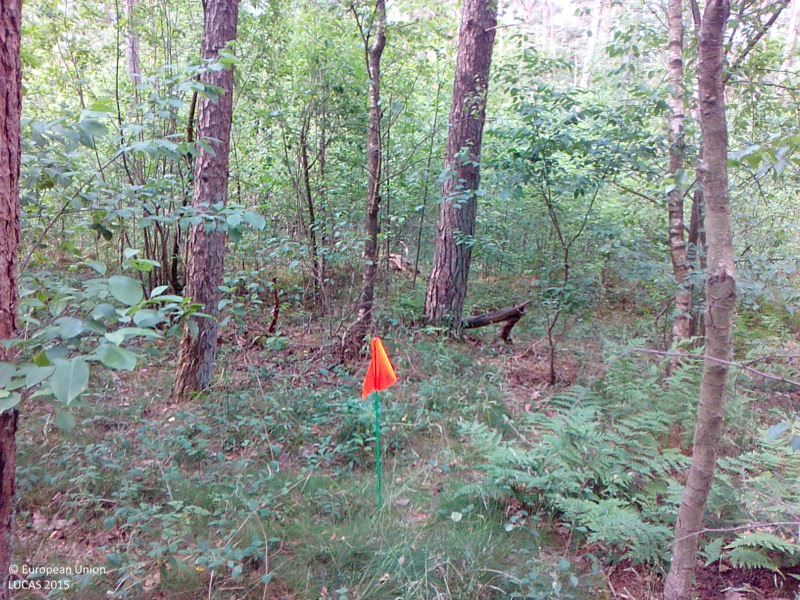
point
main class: Woodland
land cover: Pine dominated mixed woodland
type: hemiboreal forest and nemoral coniferous forest and mixed broadleaved-coniferous forest
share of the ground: > 75 %
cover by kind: coniferous forest trees 40 %, broadleaved forest trees 35 %, shrubs 15 %, herbaceous plants 10 %
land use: Forestry
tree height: > 5 m
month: June
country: DE
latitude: 52.4940
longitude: 7.4523
